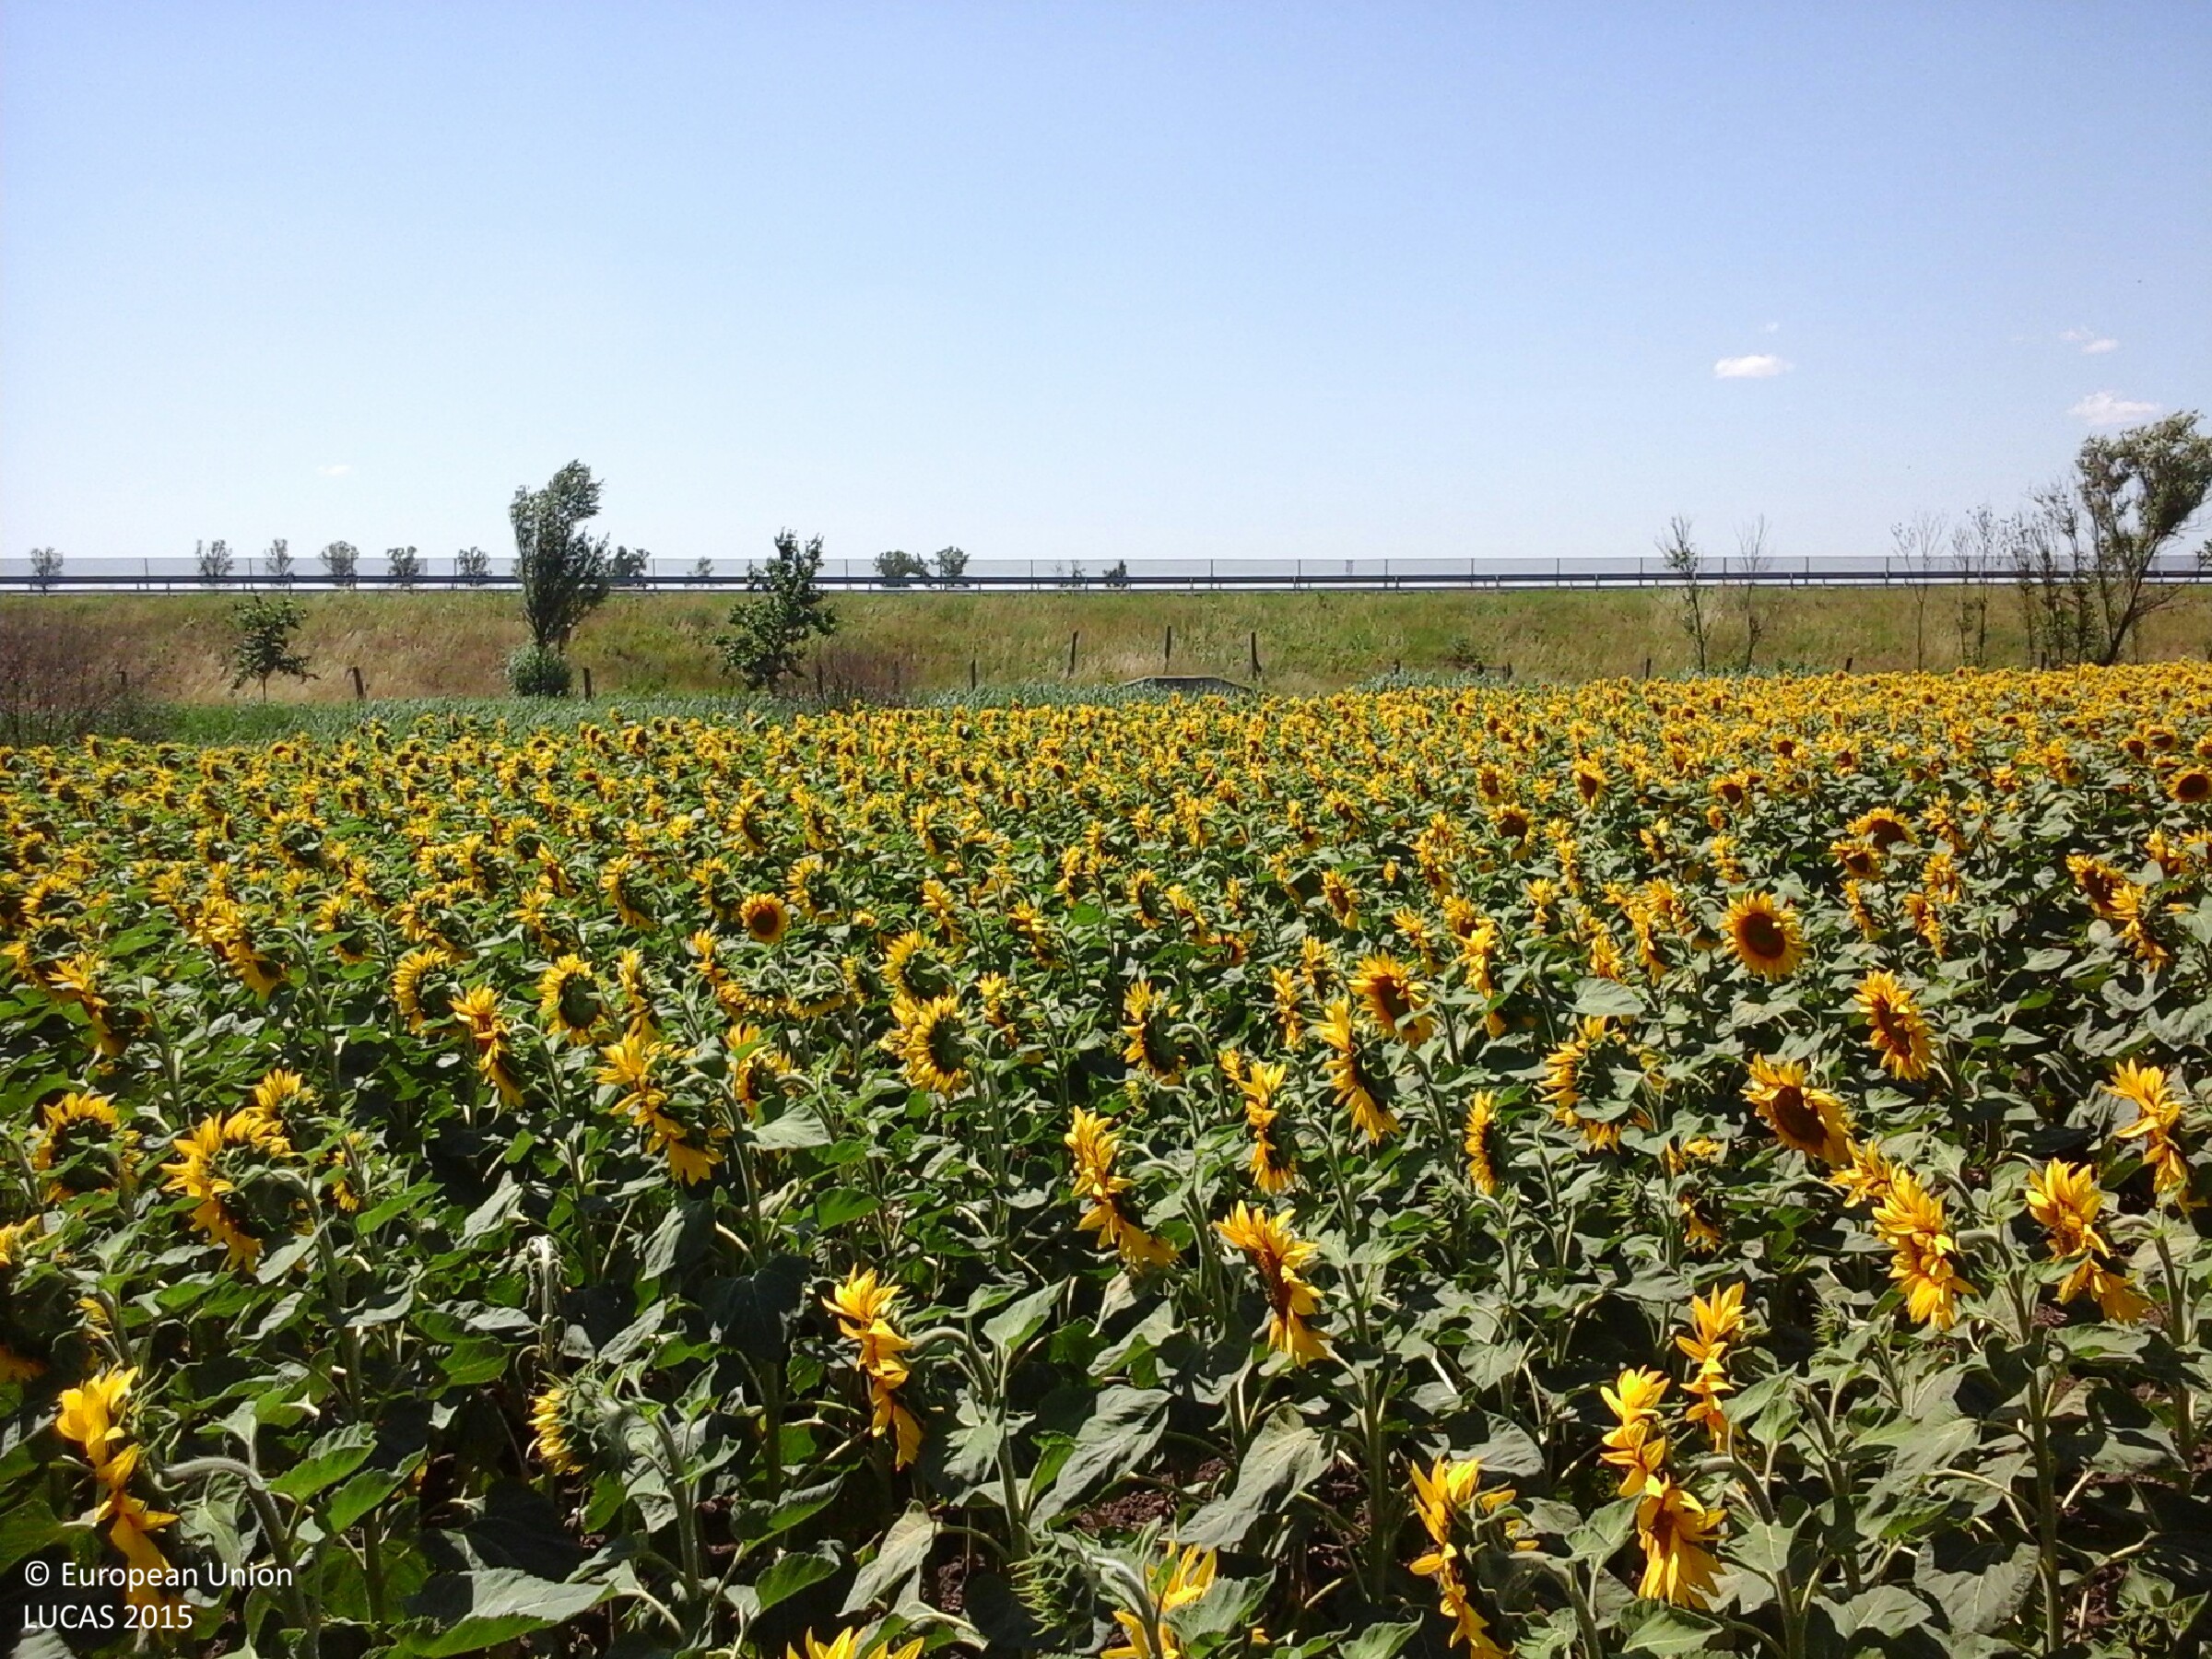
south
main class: Cropland
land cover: Sunflower
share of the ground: > 75 %
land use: Agriculture (excluding fallow land and kitchen gardens)
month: July
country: HU
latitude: 47.8855
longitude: 20.8555
